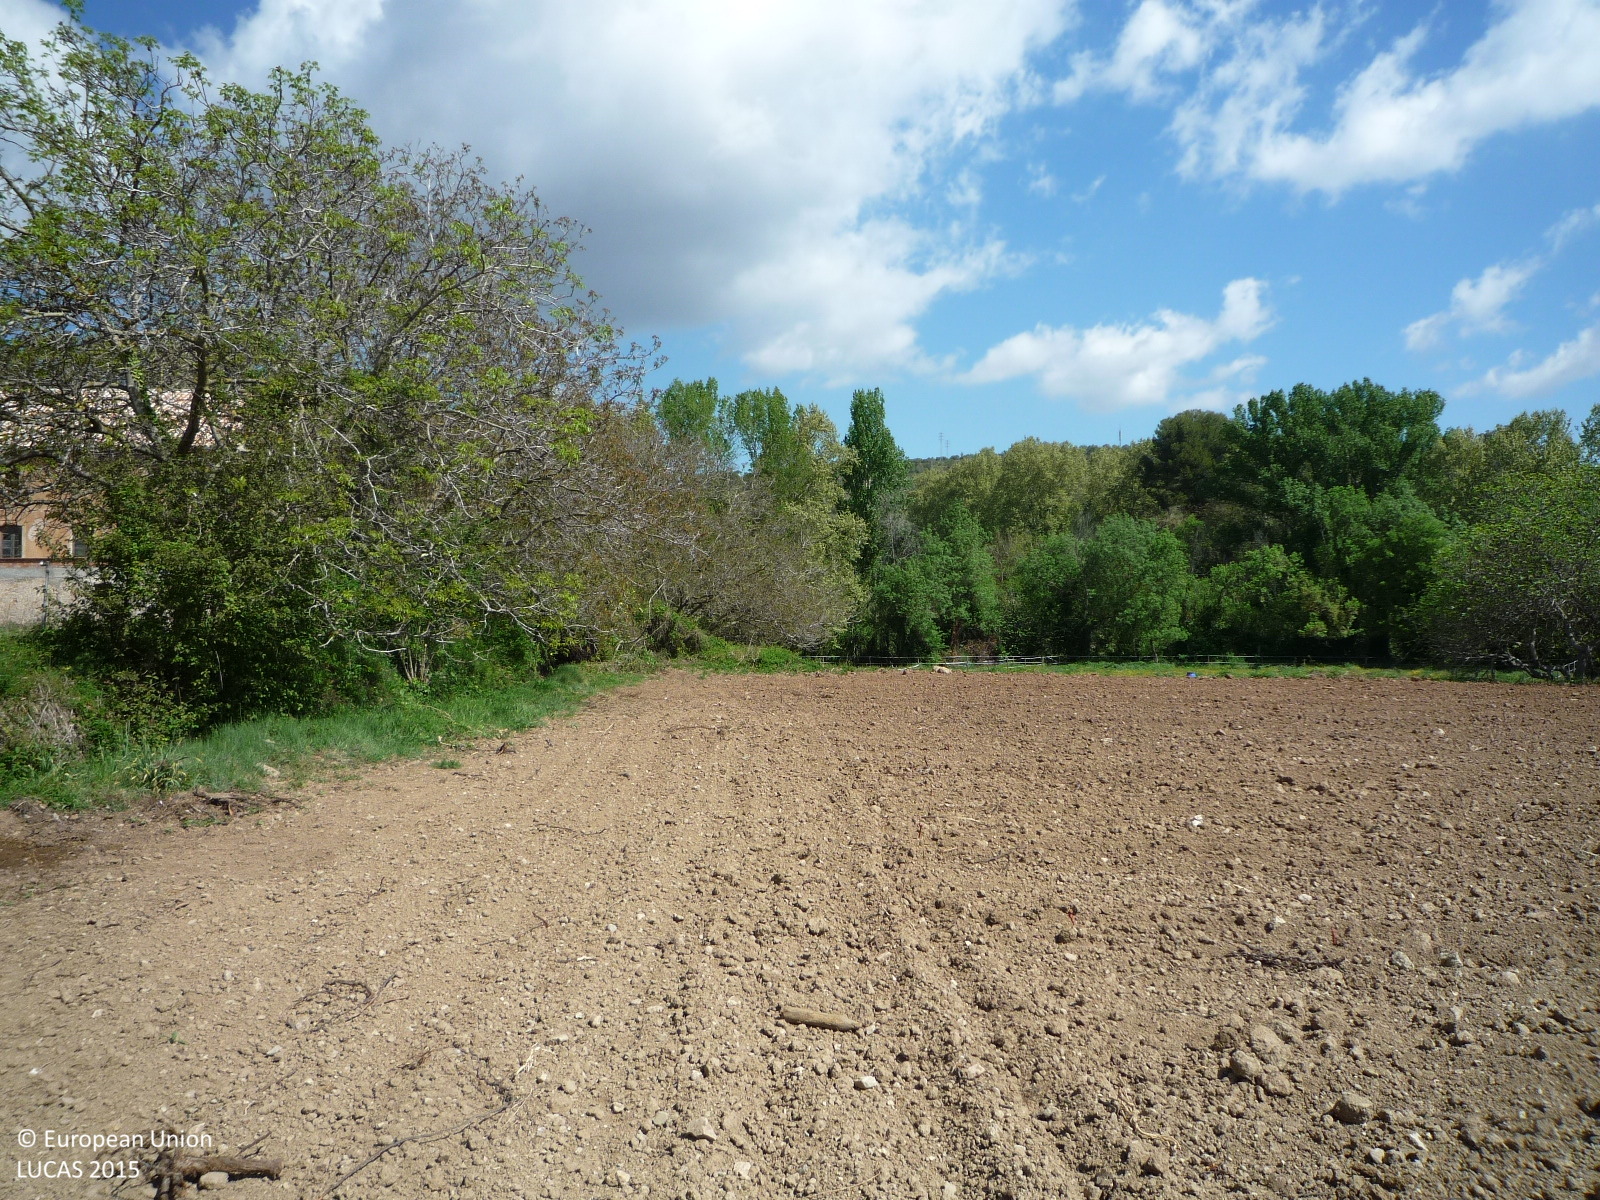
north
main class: Cropland
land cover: Vineyards
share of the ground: < 10 %
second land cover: Other bare soil
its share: > 75 %
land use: Agriculture (excluding fallow land and kitchen gardens)
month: April
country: ES
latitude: 41.4574
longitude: 1.6723
